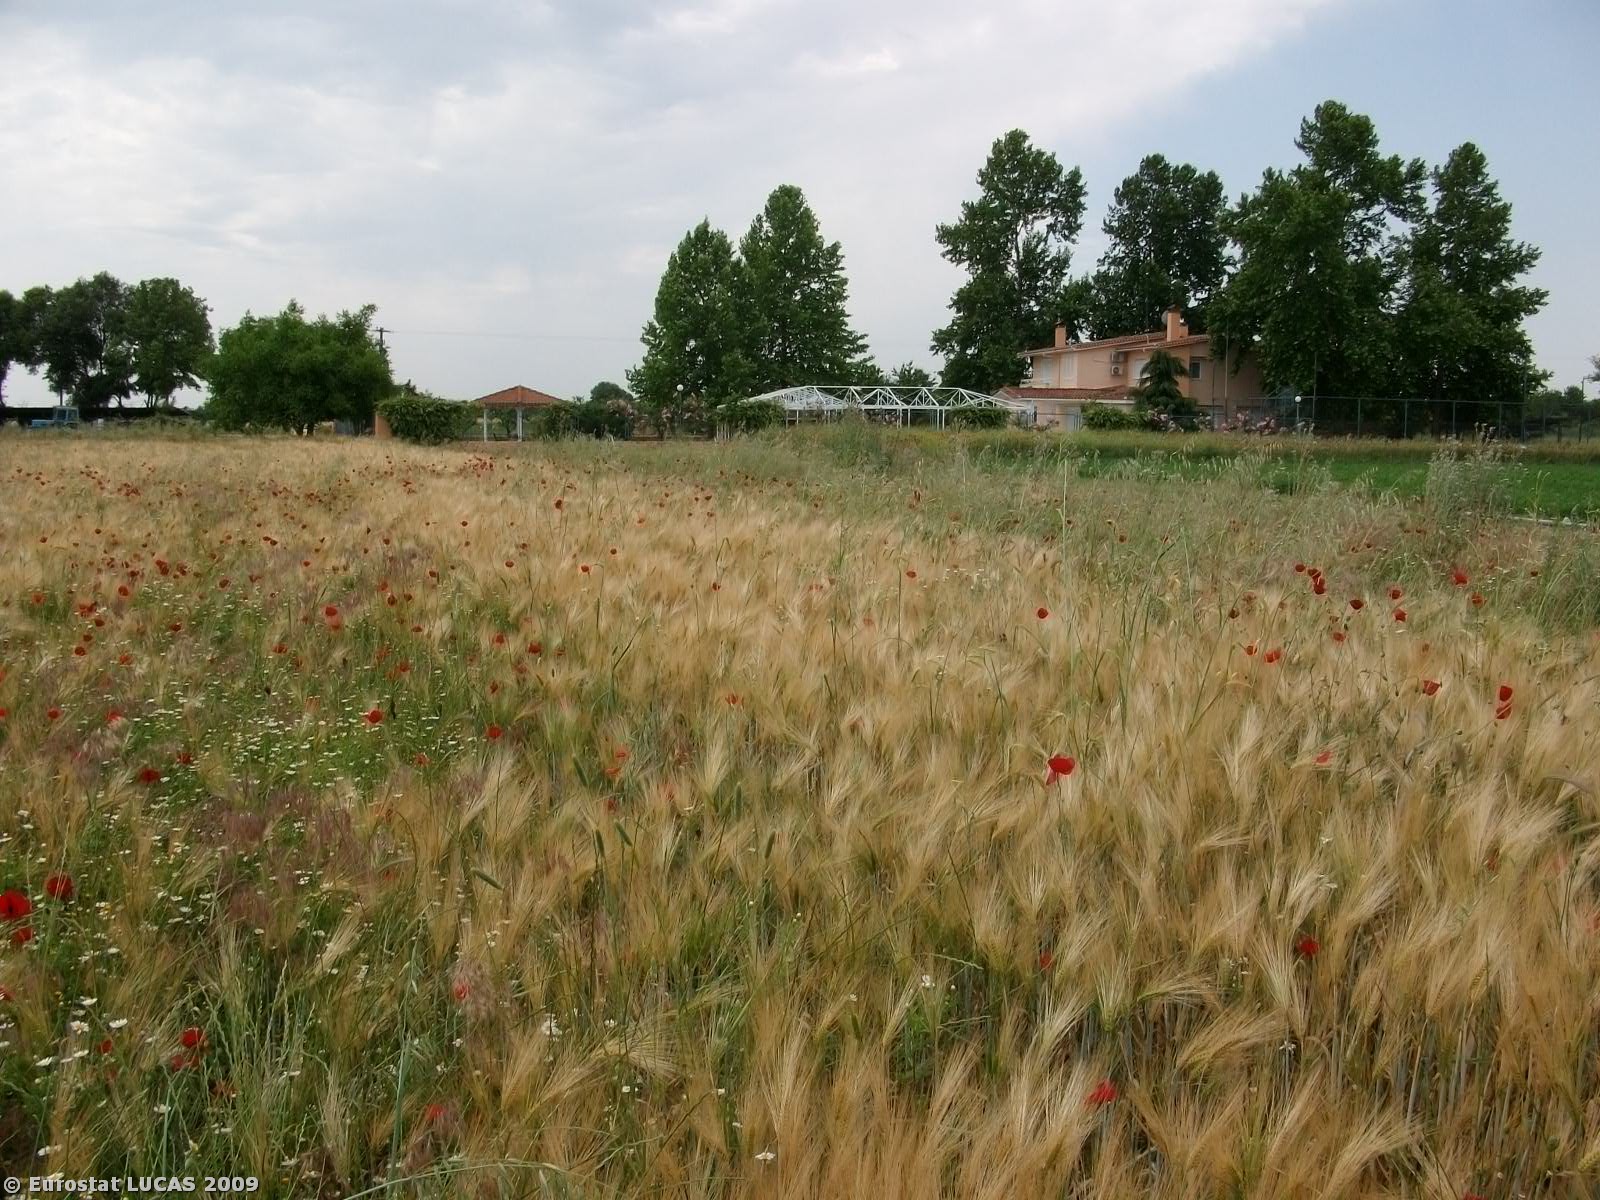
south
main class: Cropland
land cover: Durum wheat
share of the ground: > 75 %
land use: Agriculture (excluding fallow land and kitchen gardens)
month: May
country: GR
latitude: 39.7371
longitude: 22.3710
